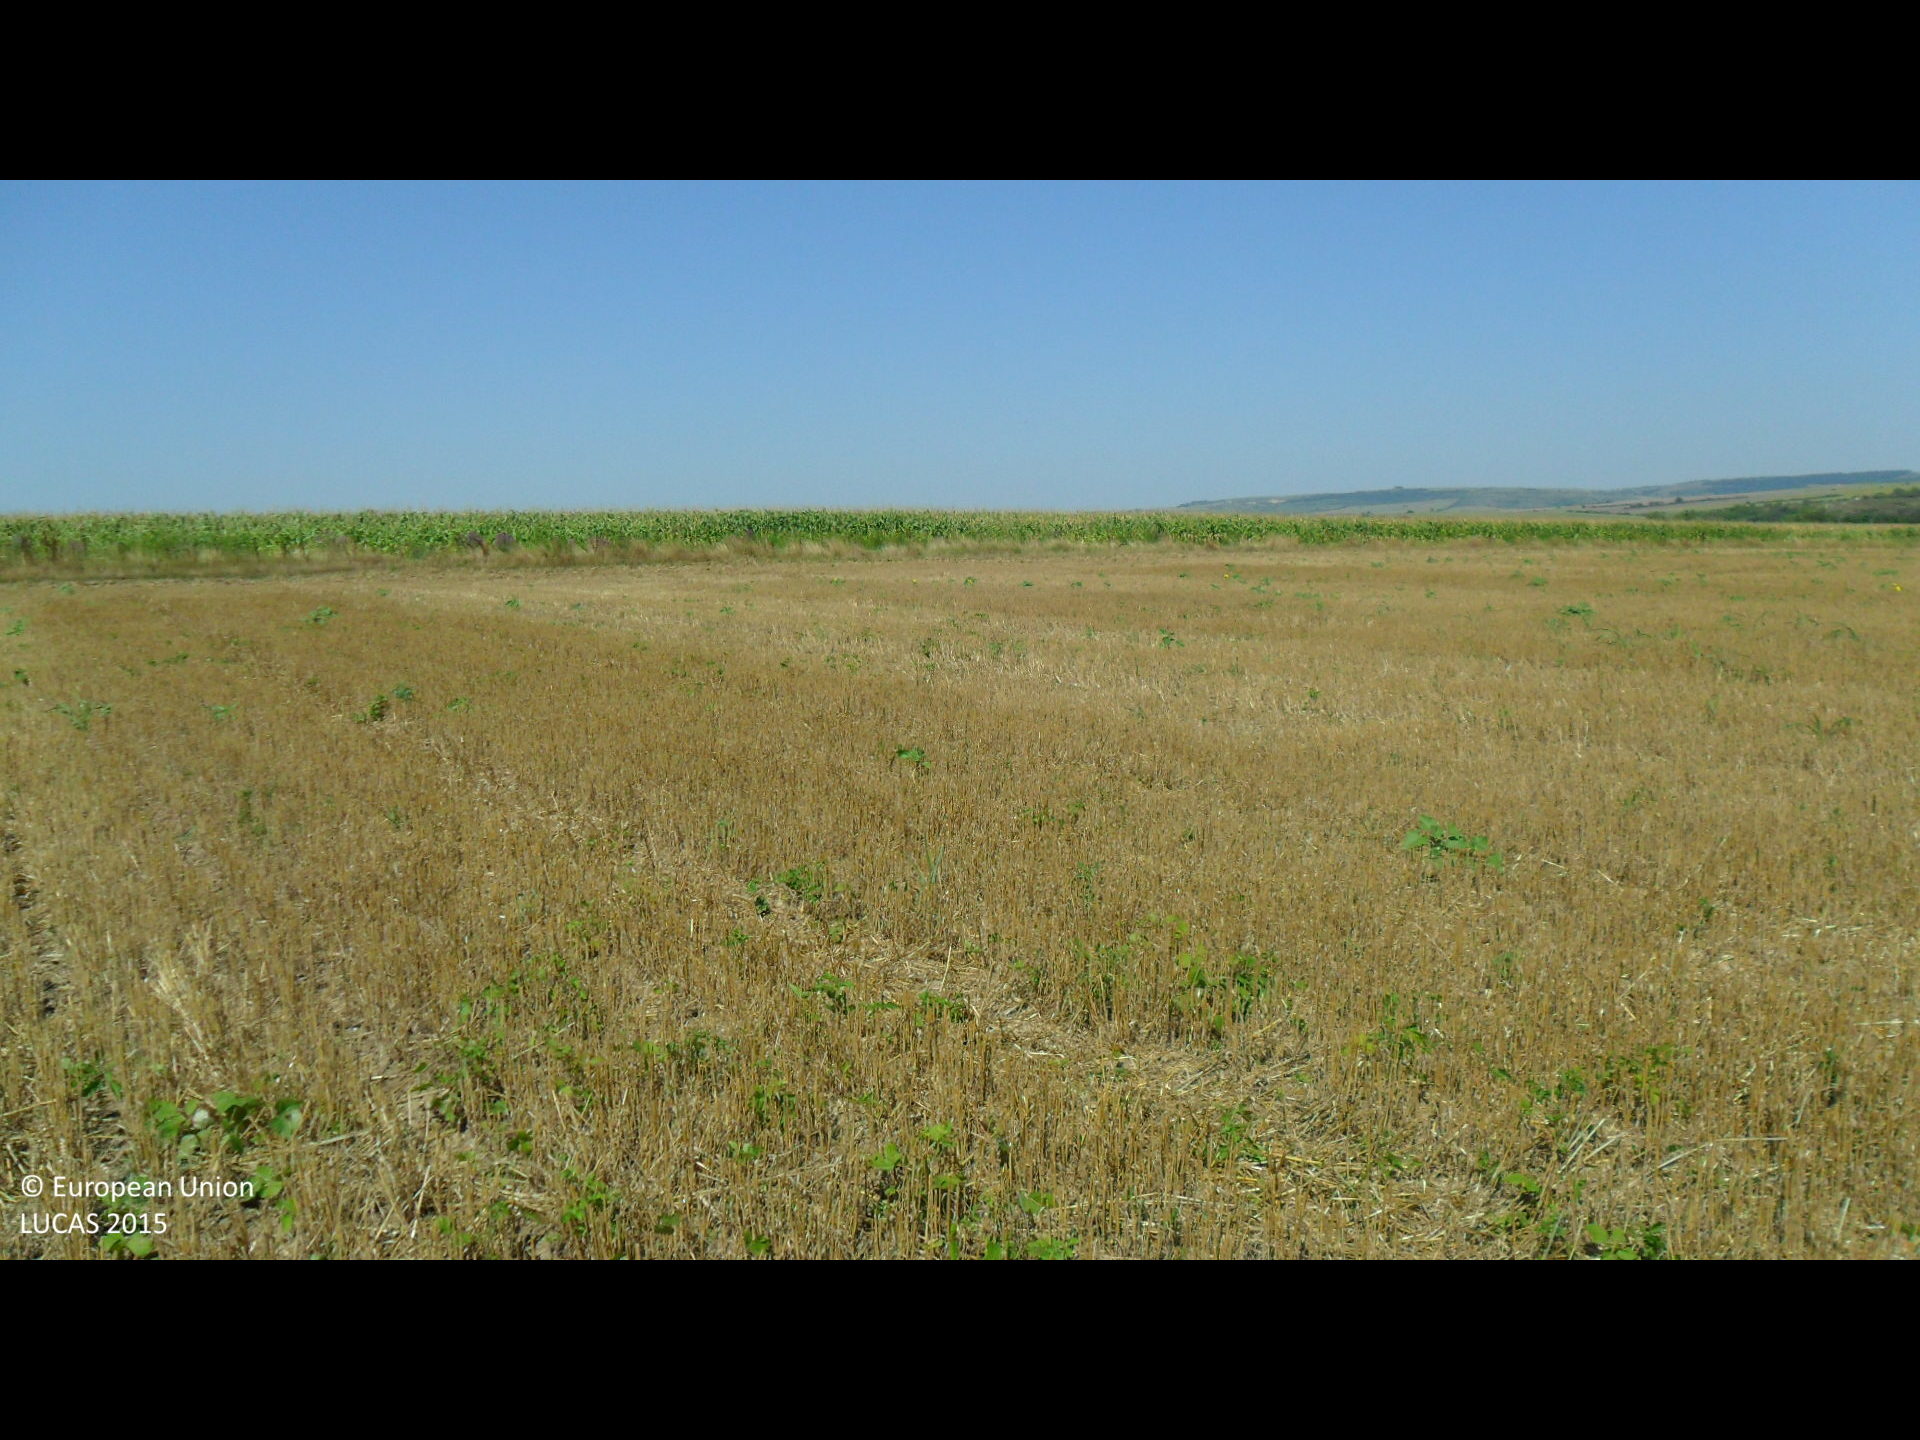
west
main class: Cropland
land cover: Barley
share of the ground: < 10 %
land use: Agriculture (excluding fallow land and kitchen gardens)
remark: Harvested field
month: August
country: BG
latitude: 43.3439
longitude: 26.1936
